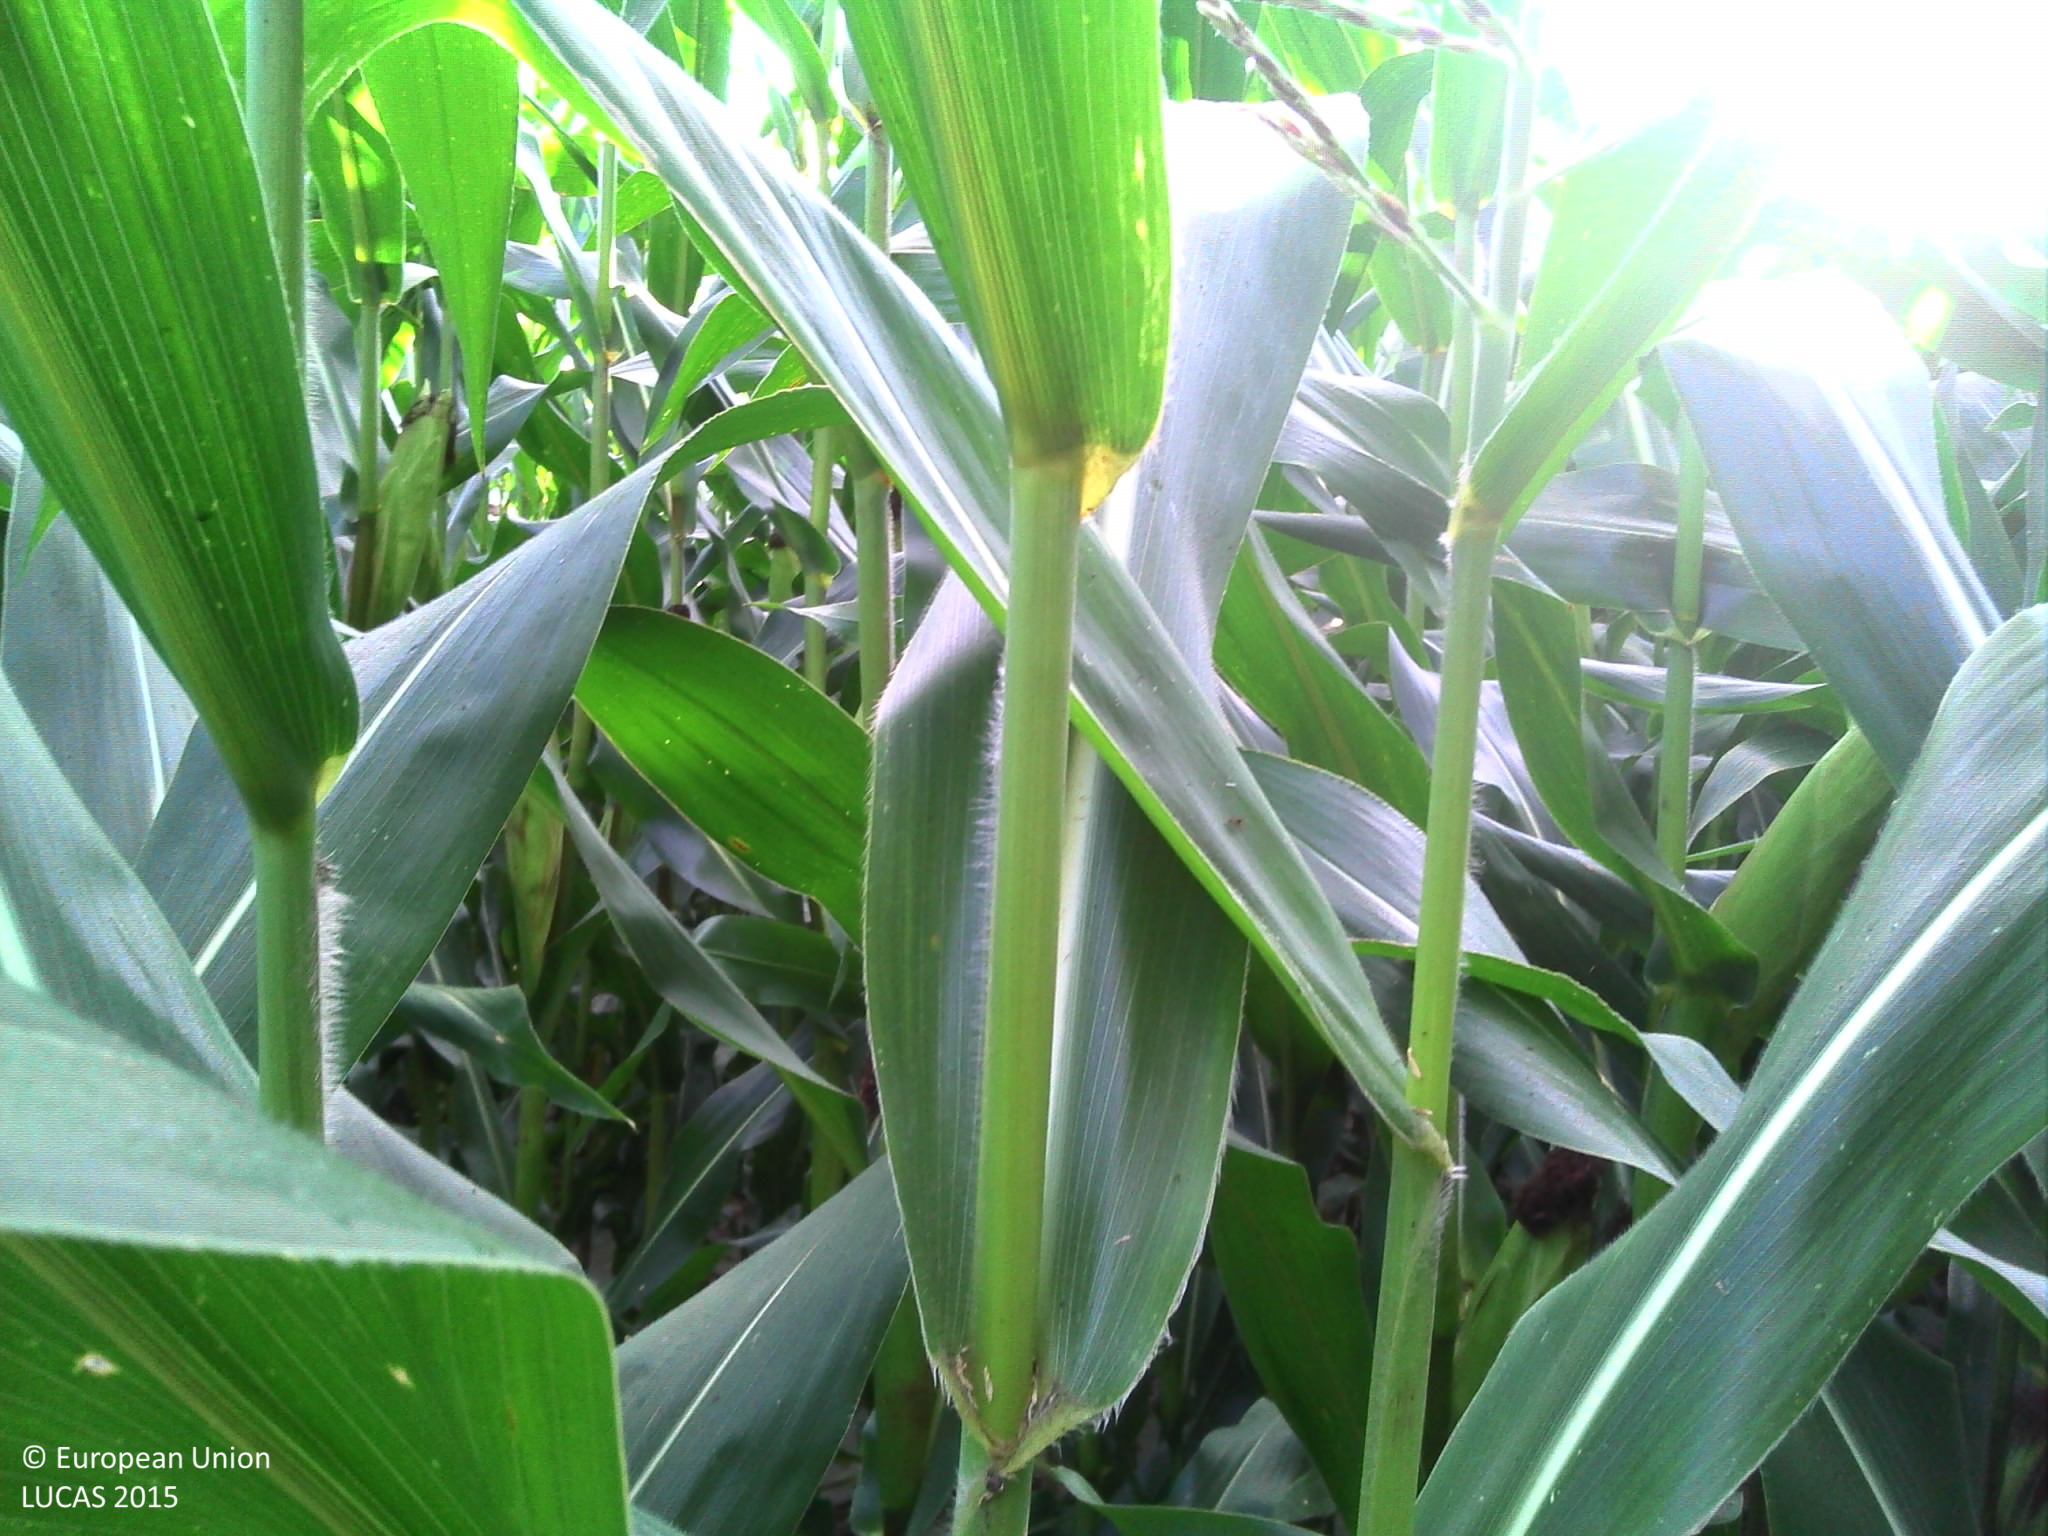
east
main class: Cropland
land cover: Maize
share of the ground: > 75 %
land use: Agriculture (excluding fallow land and kitchen gardens)
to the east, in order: Maize; Single bushes/trees; Conifer hedges; Maize; Tracks; Maize
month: October
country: FR
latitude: 48.0497
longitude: -2.3868
